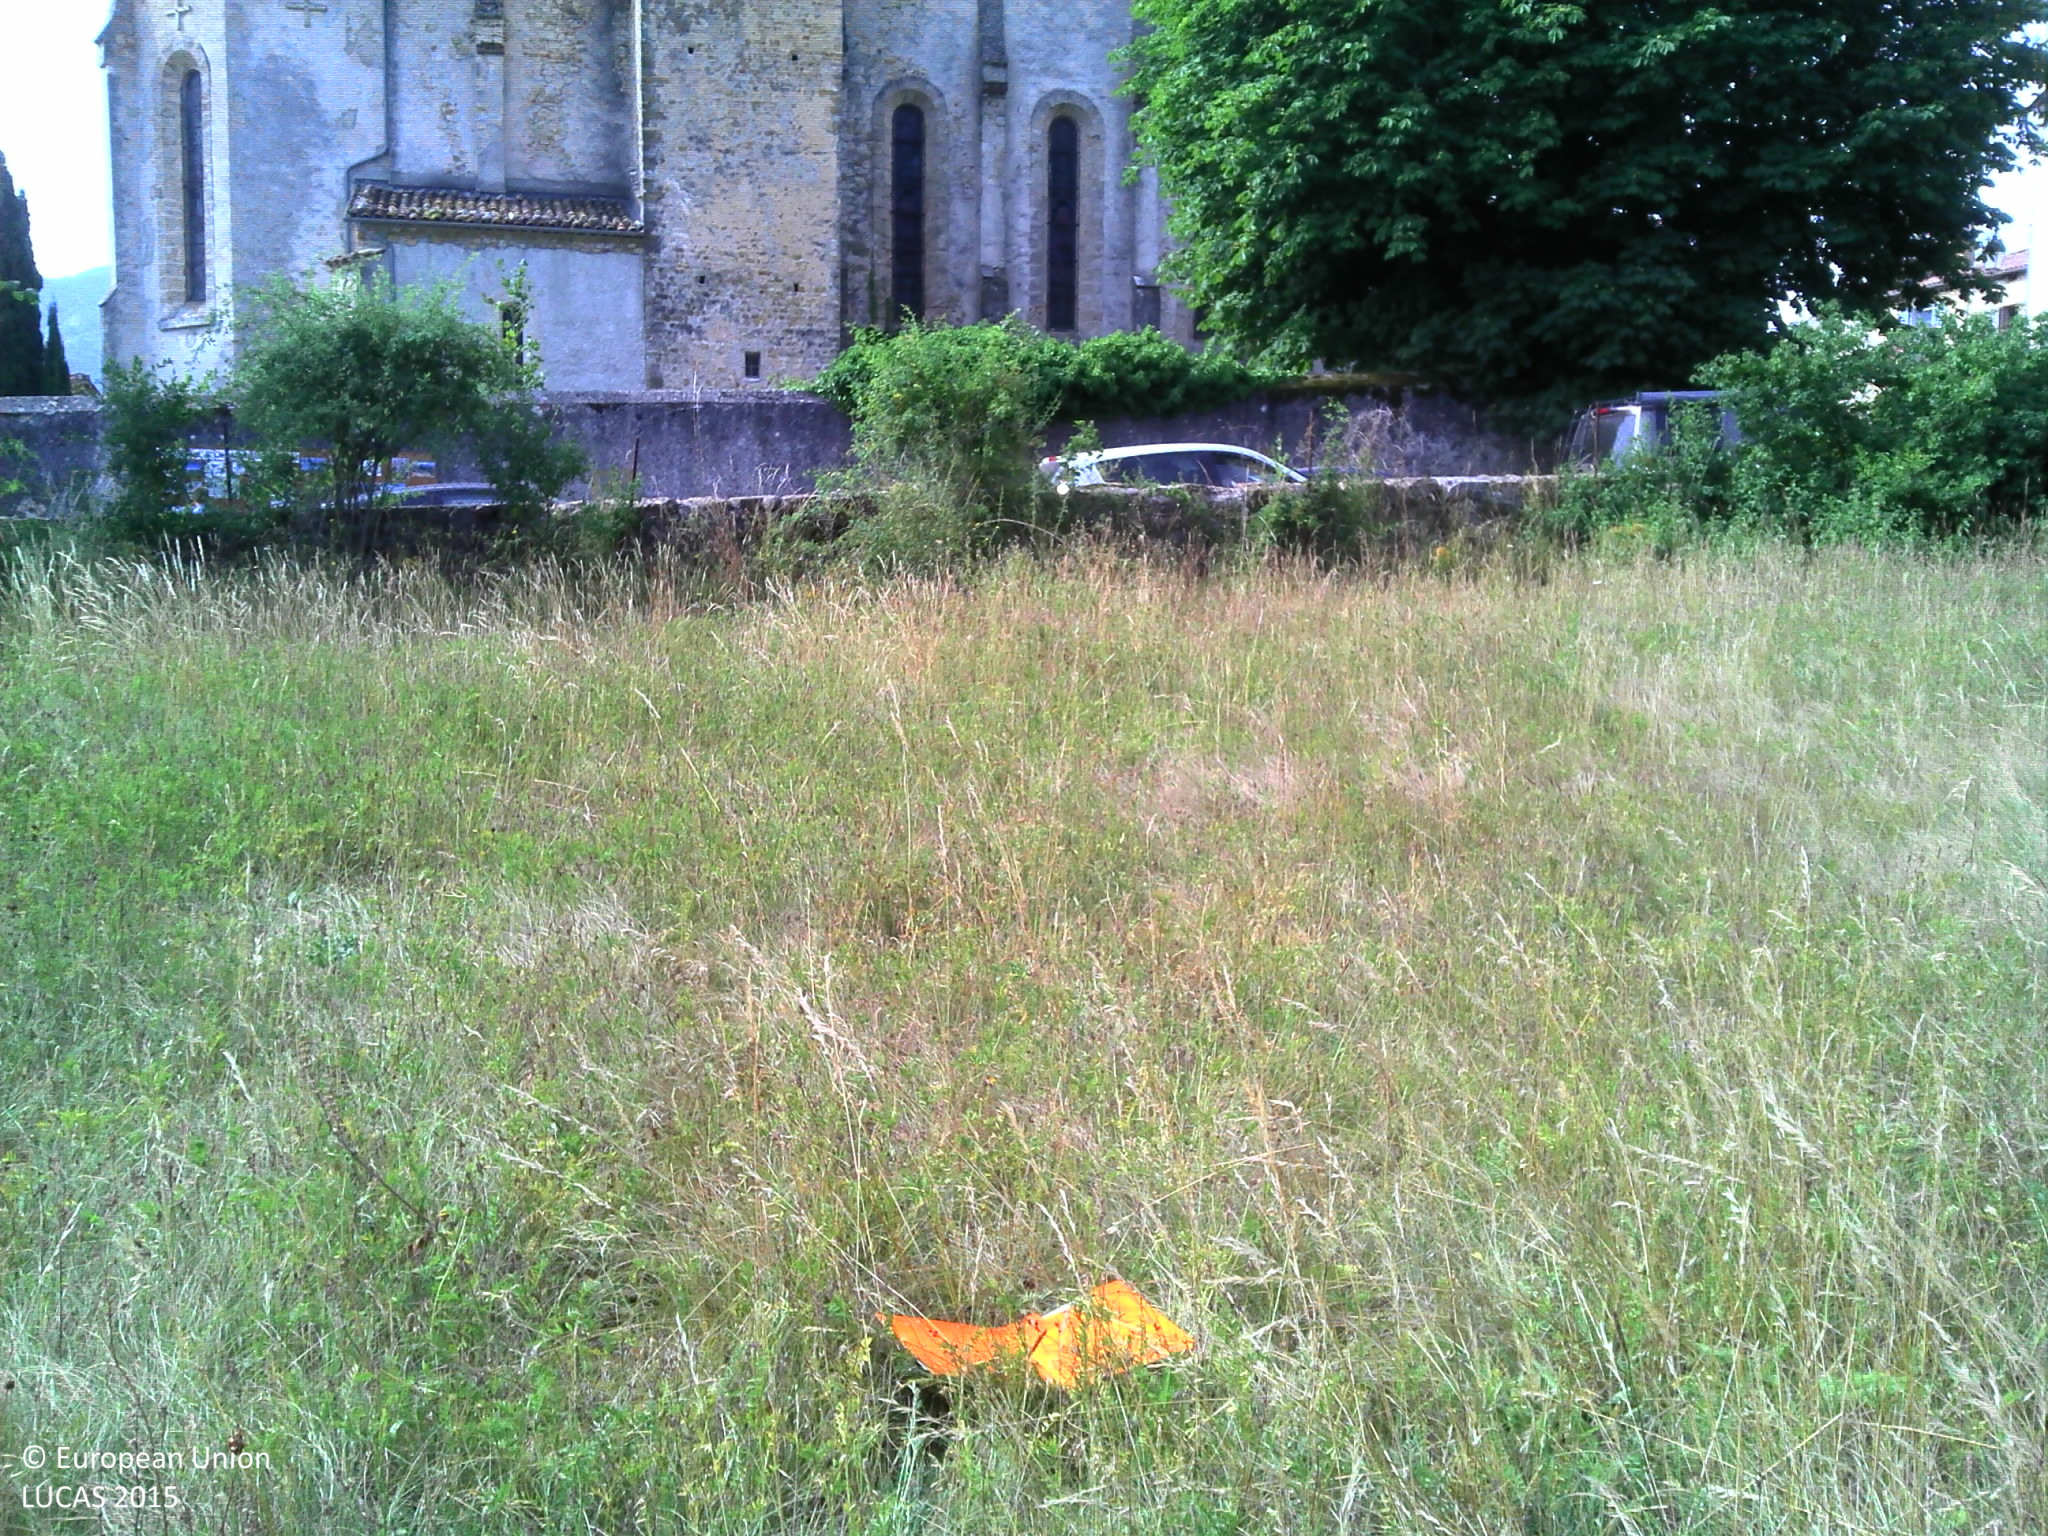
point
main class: Grassland
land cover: Grassland without tree/shrub cover
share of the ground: > 75 %
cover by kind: herbaceous plants 100 %
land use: Agriculture (excluding fallow land and kitchen gardens)
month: July
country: FR
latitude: 43.7805
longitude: 6.3427
